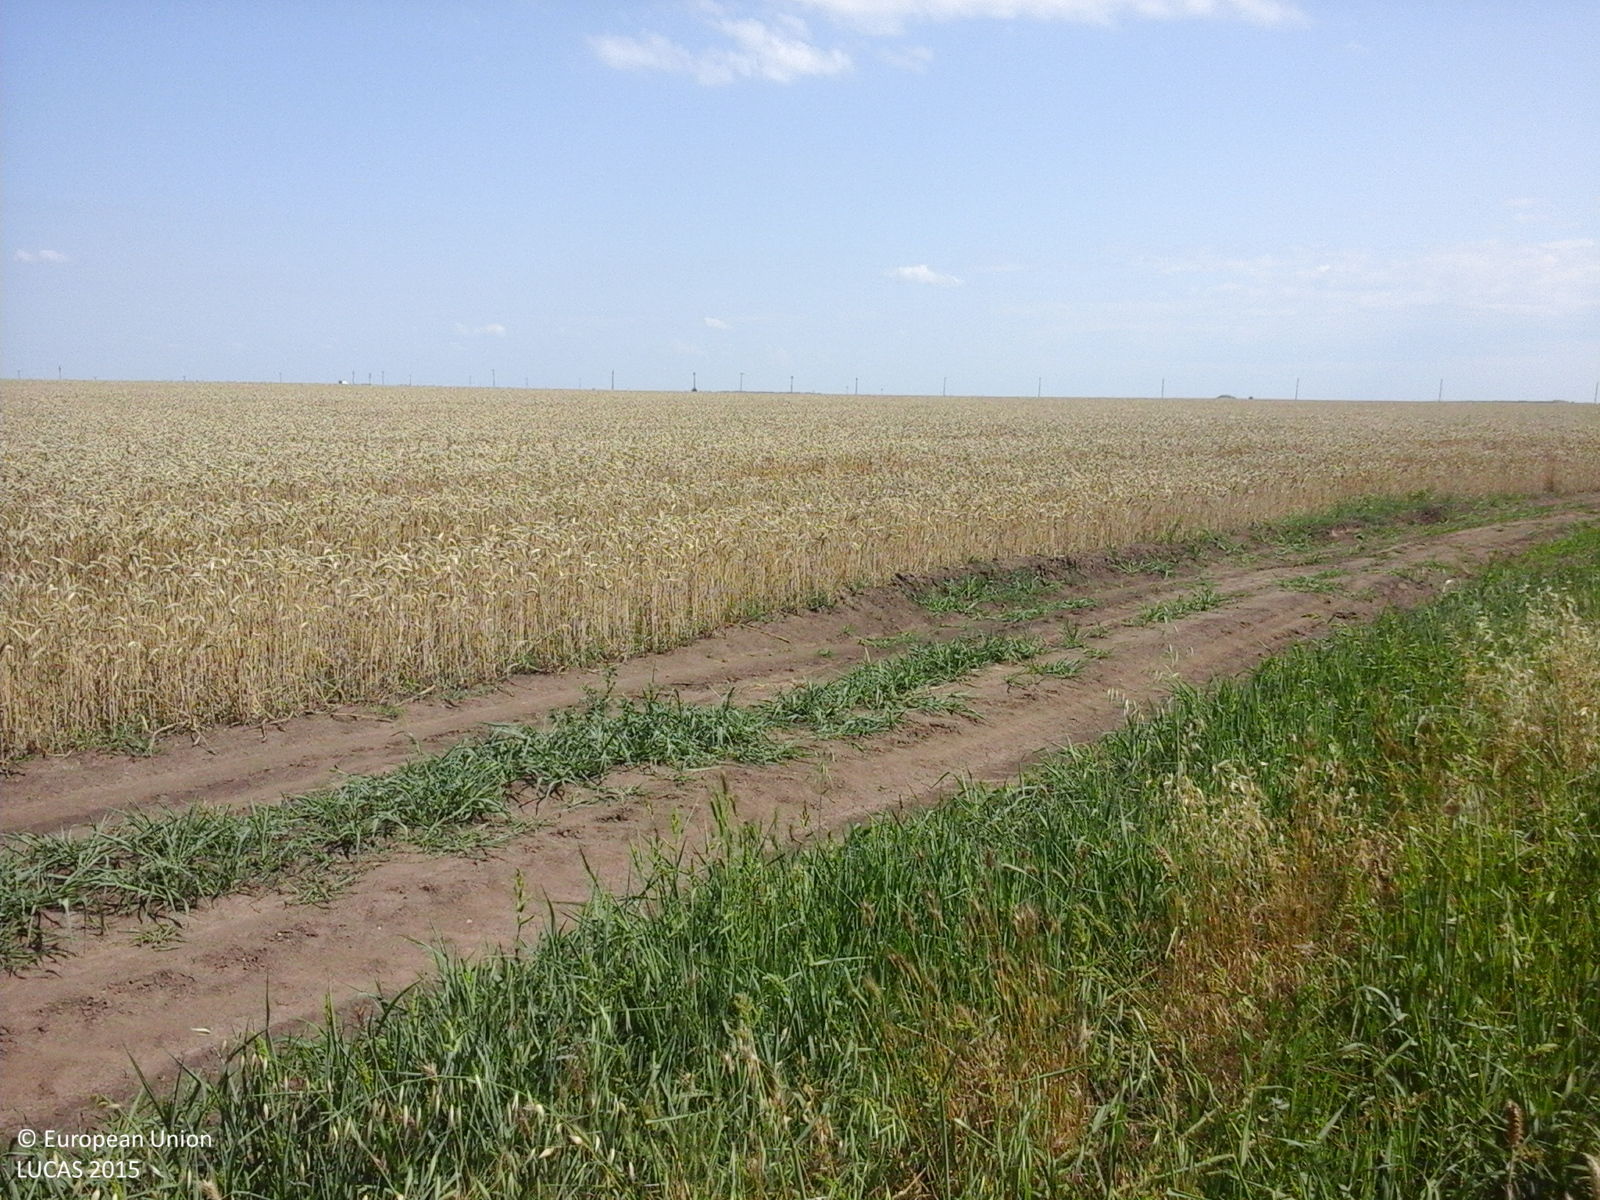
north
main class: Cropland
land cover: Common wheat
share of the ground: > 75 %
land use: Agriculture (excluding fallow land and kitchen gardens)
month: July
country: RO
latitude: 43.9494
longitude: 25.2450
